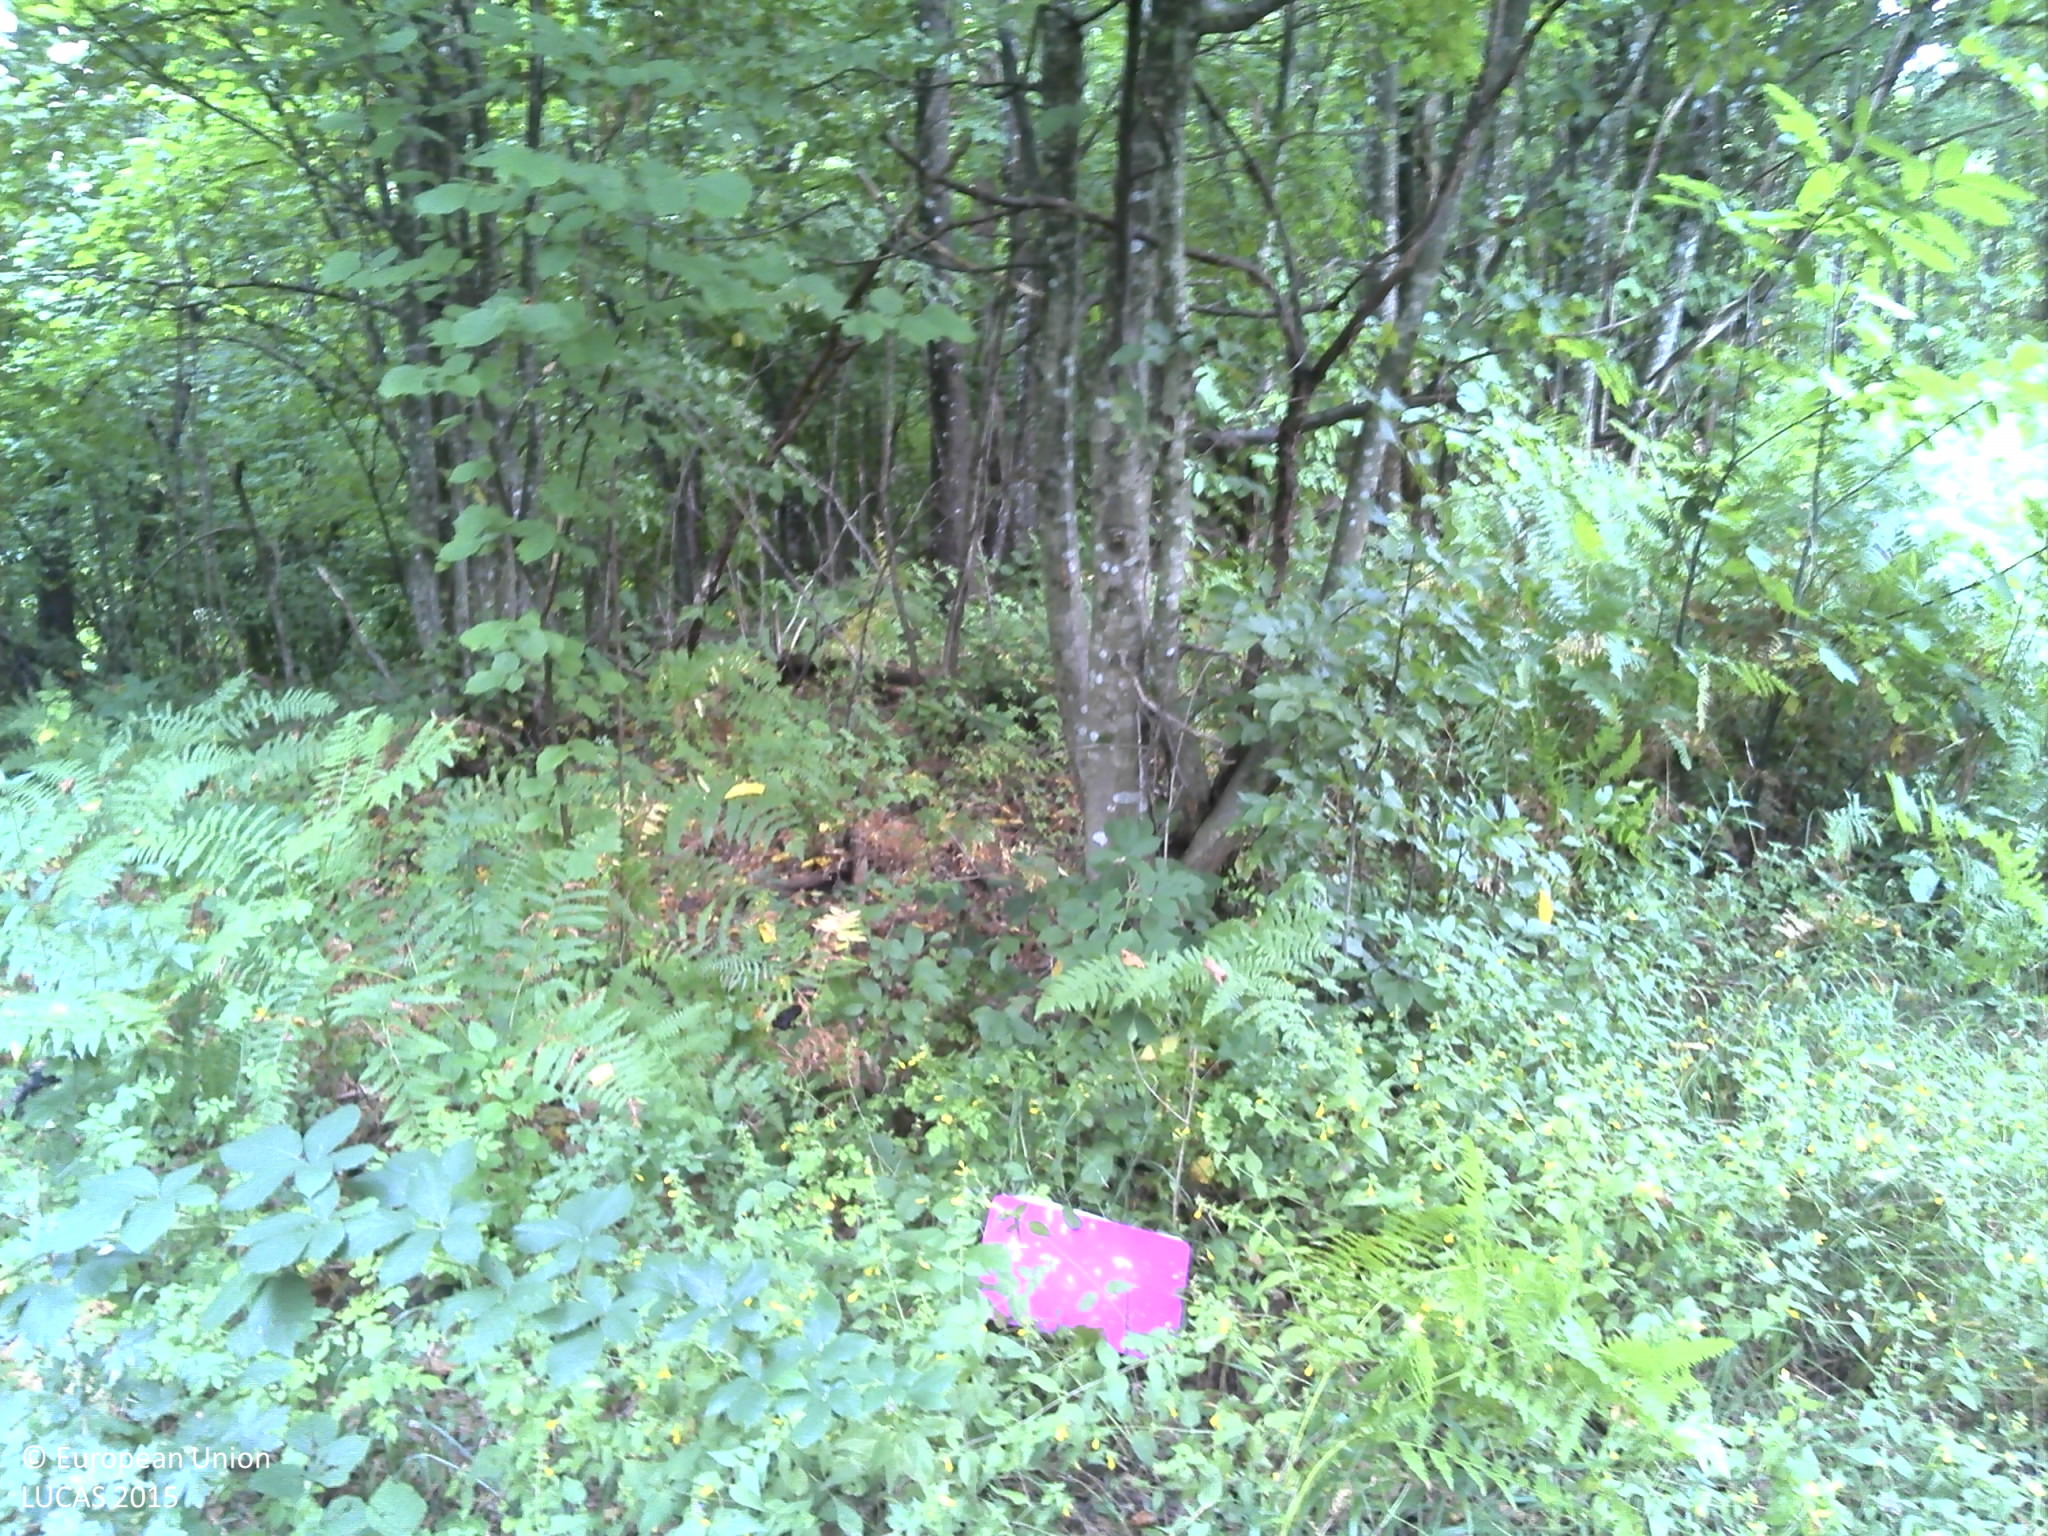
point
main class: Woodland
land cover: Broadleaved woodland
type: beech forest
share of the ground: > 75 %
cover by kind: broadleaved forest trees 100 %
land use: Forestry
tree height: > 5 m
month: August
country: HR
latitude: 45.2722
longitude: 16.1276
